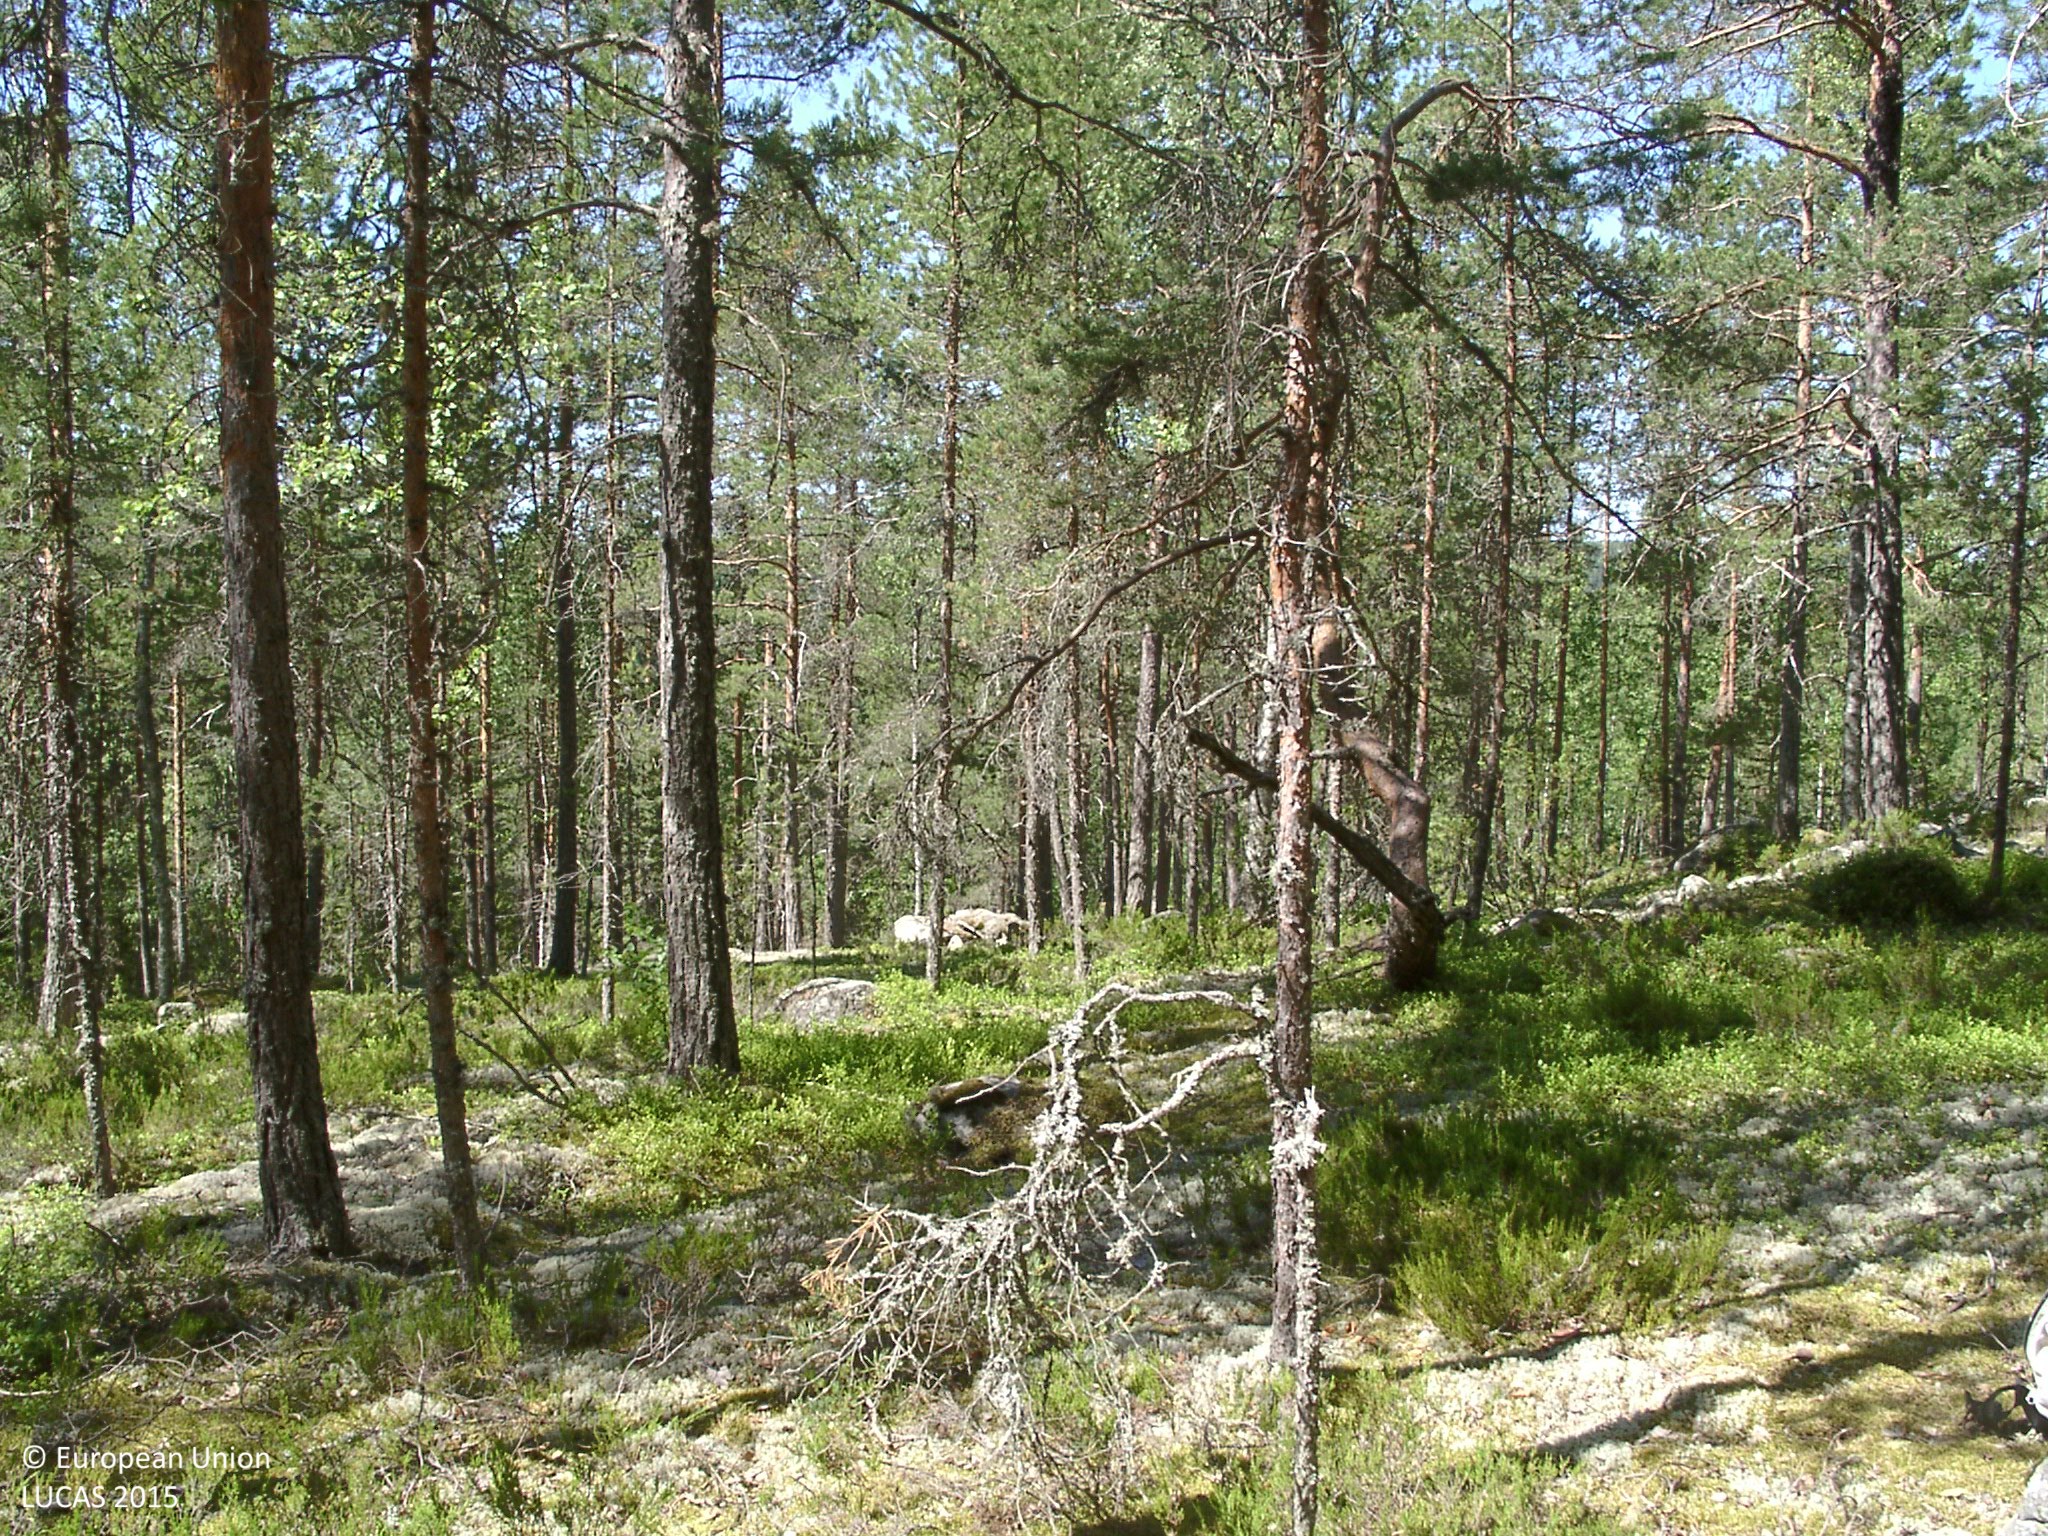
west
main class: Woodland
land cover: Pine dominated coniferous woodland
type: boreal forest
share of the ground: 50 - 75 %
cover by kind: coniferous forest trees 50 %, shrubs 30 %, lichens and mosses 10 %, broadleaved forest trees 5 %, consolidated bare surface 5 %
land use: Semi-natural and natural areas not in use
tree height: > 5 m
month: July
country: FI
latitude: 61.9808
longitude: 25.5553
